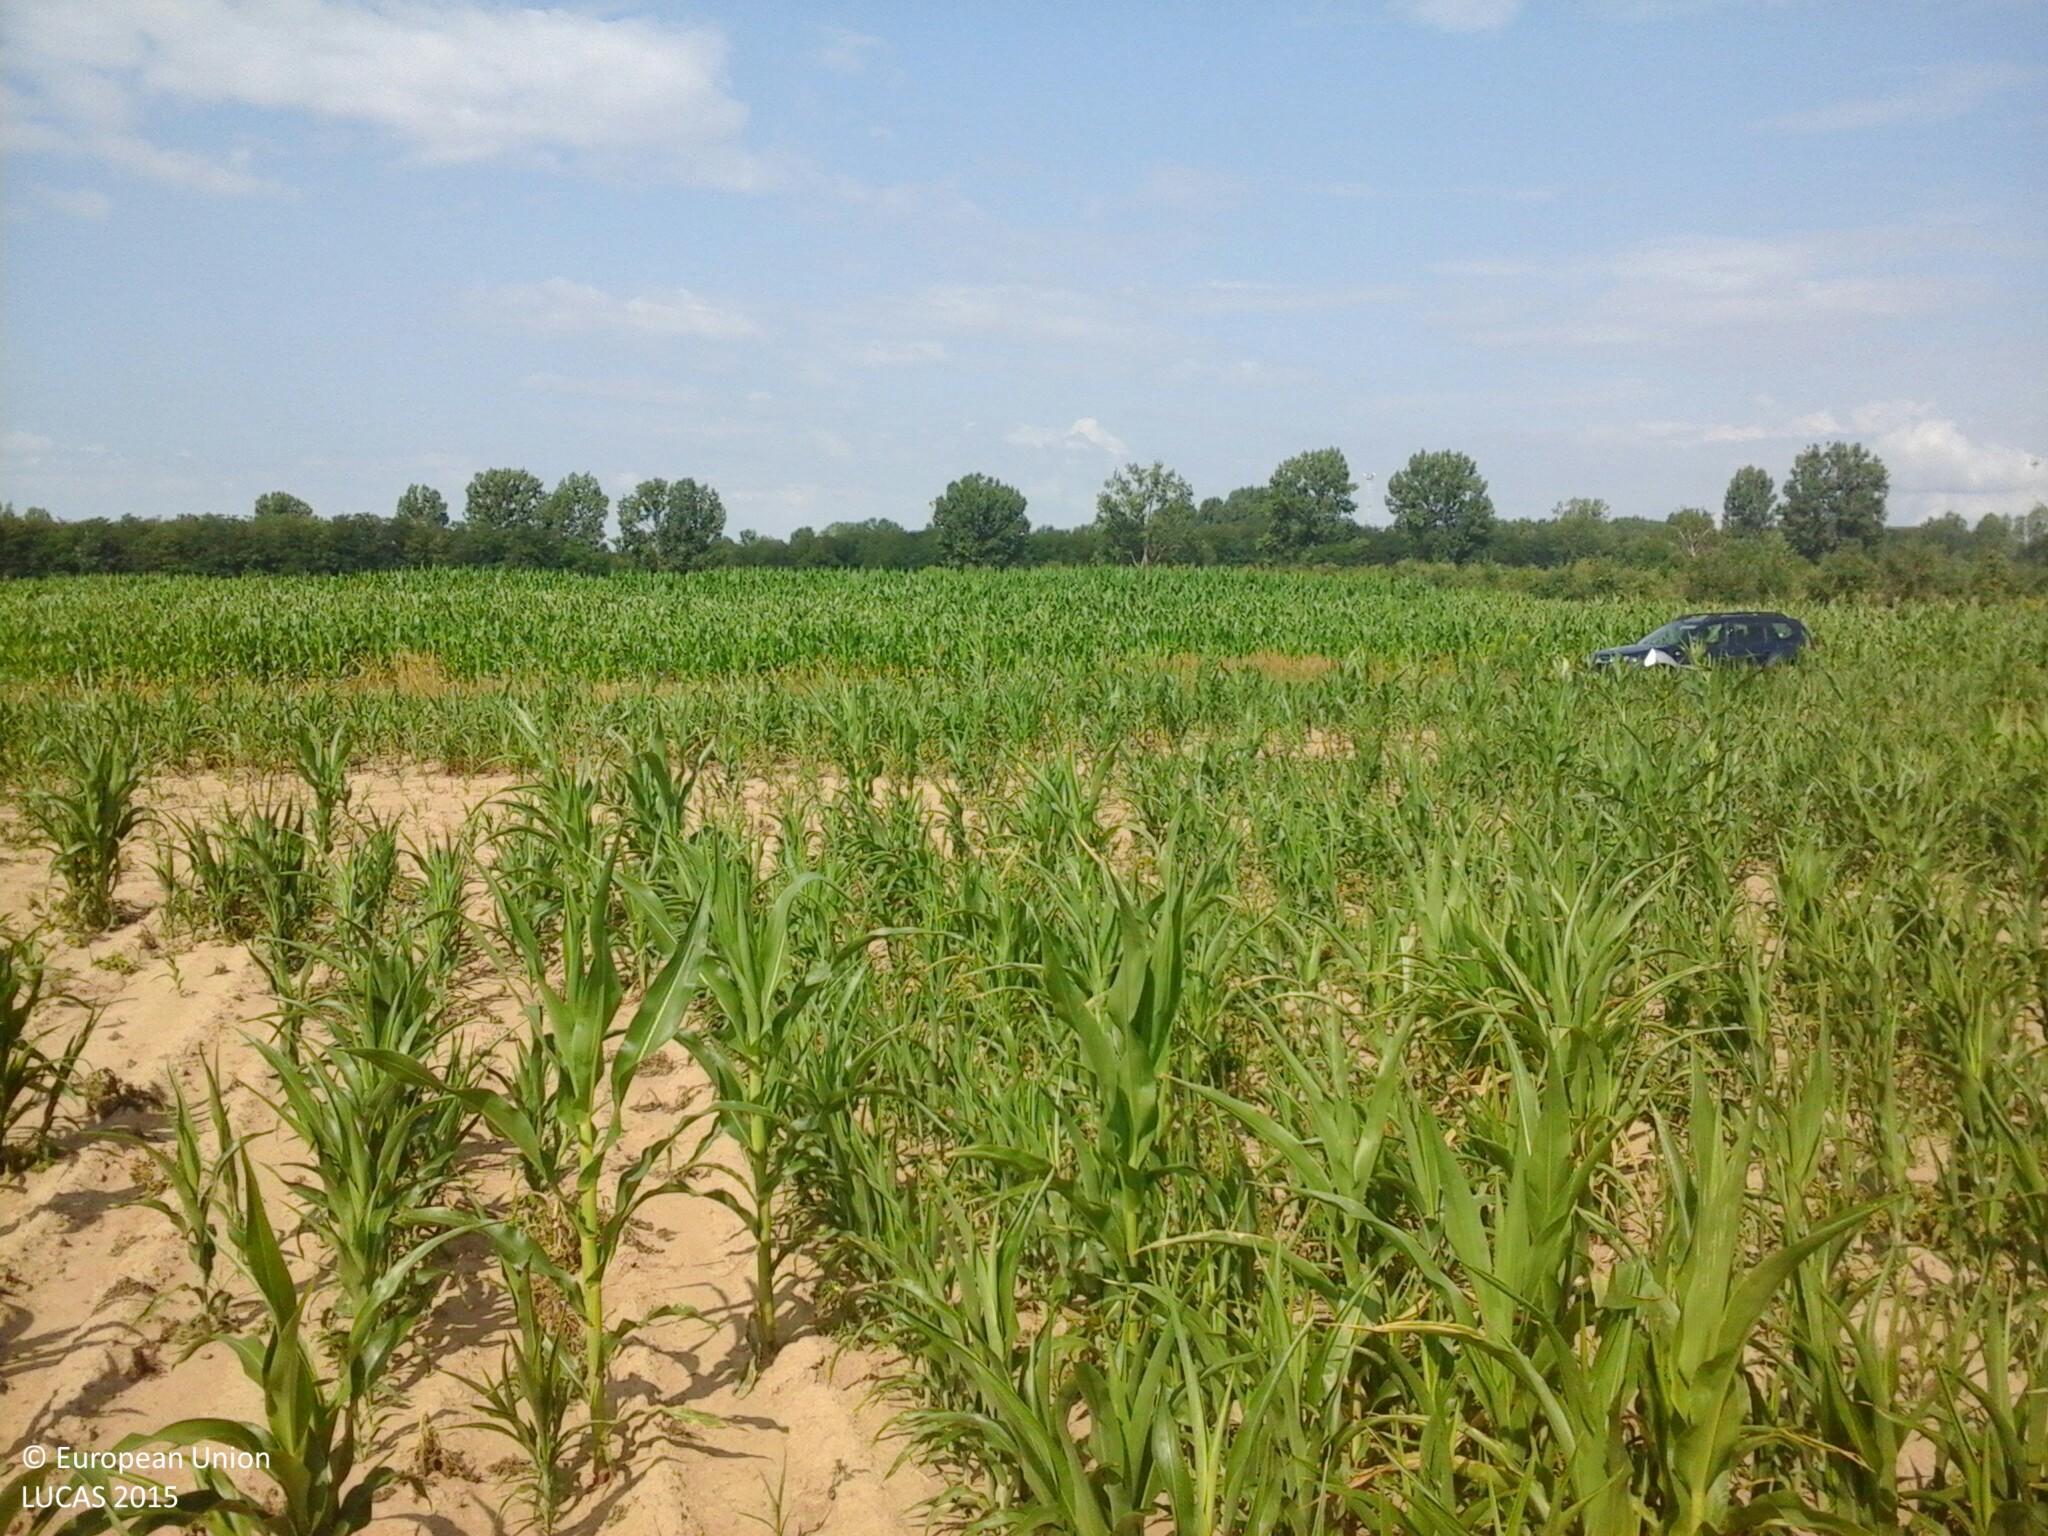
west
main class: Cropland
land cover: Maize
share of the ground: 50 - 75 %
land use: Agriculture (excluding fallow land and kitchen gardens)
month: July
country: HU
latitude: 48.3983
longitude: 22.1992
